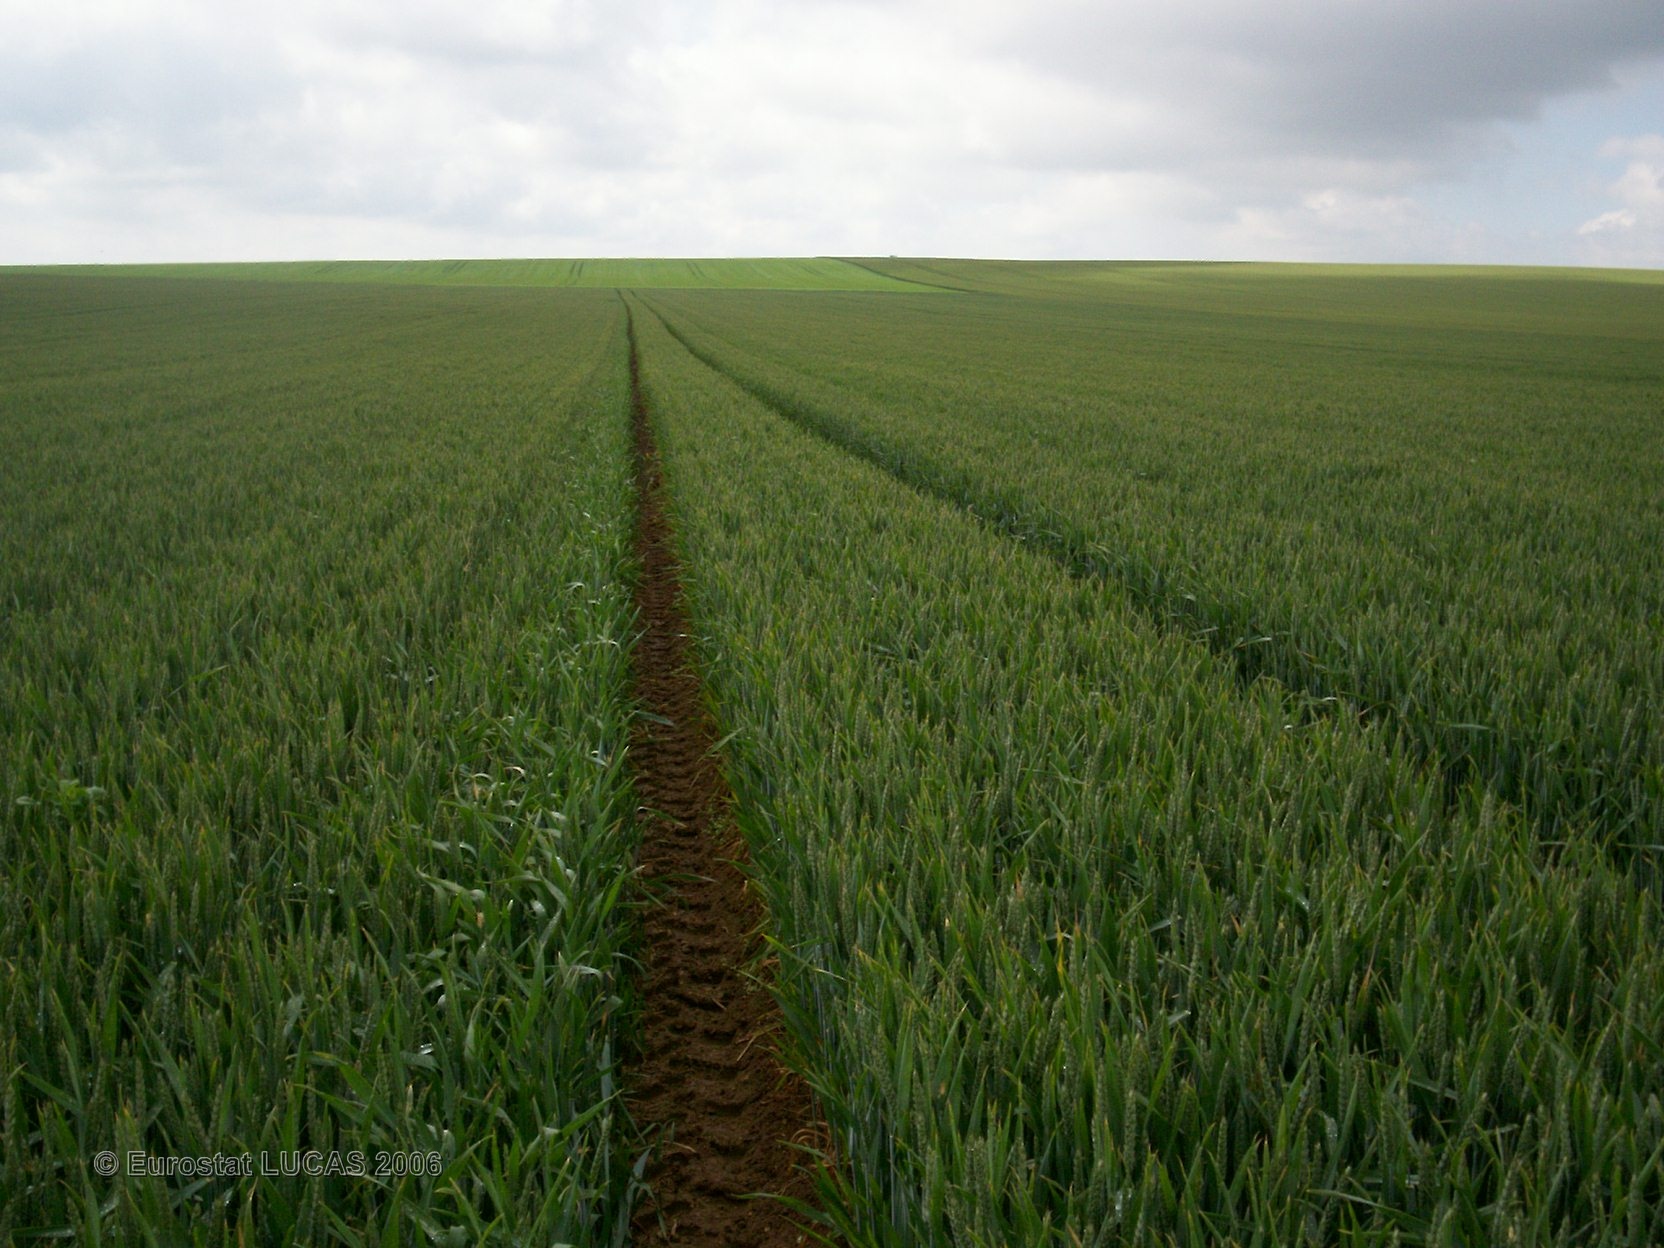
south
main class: Cropland
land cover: Common wheat
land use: Agriculture (excluding fallow land and kitchen gardens)
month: June
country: FR
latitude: 48.5723
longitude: 4.4810
